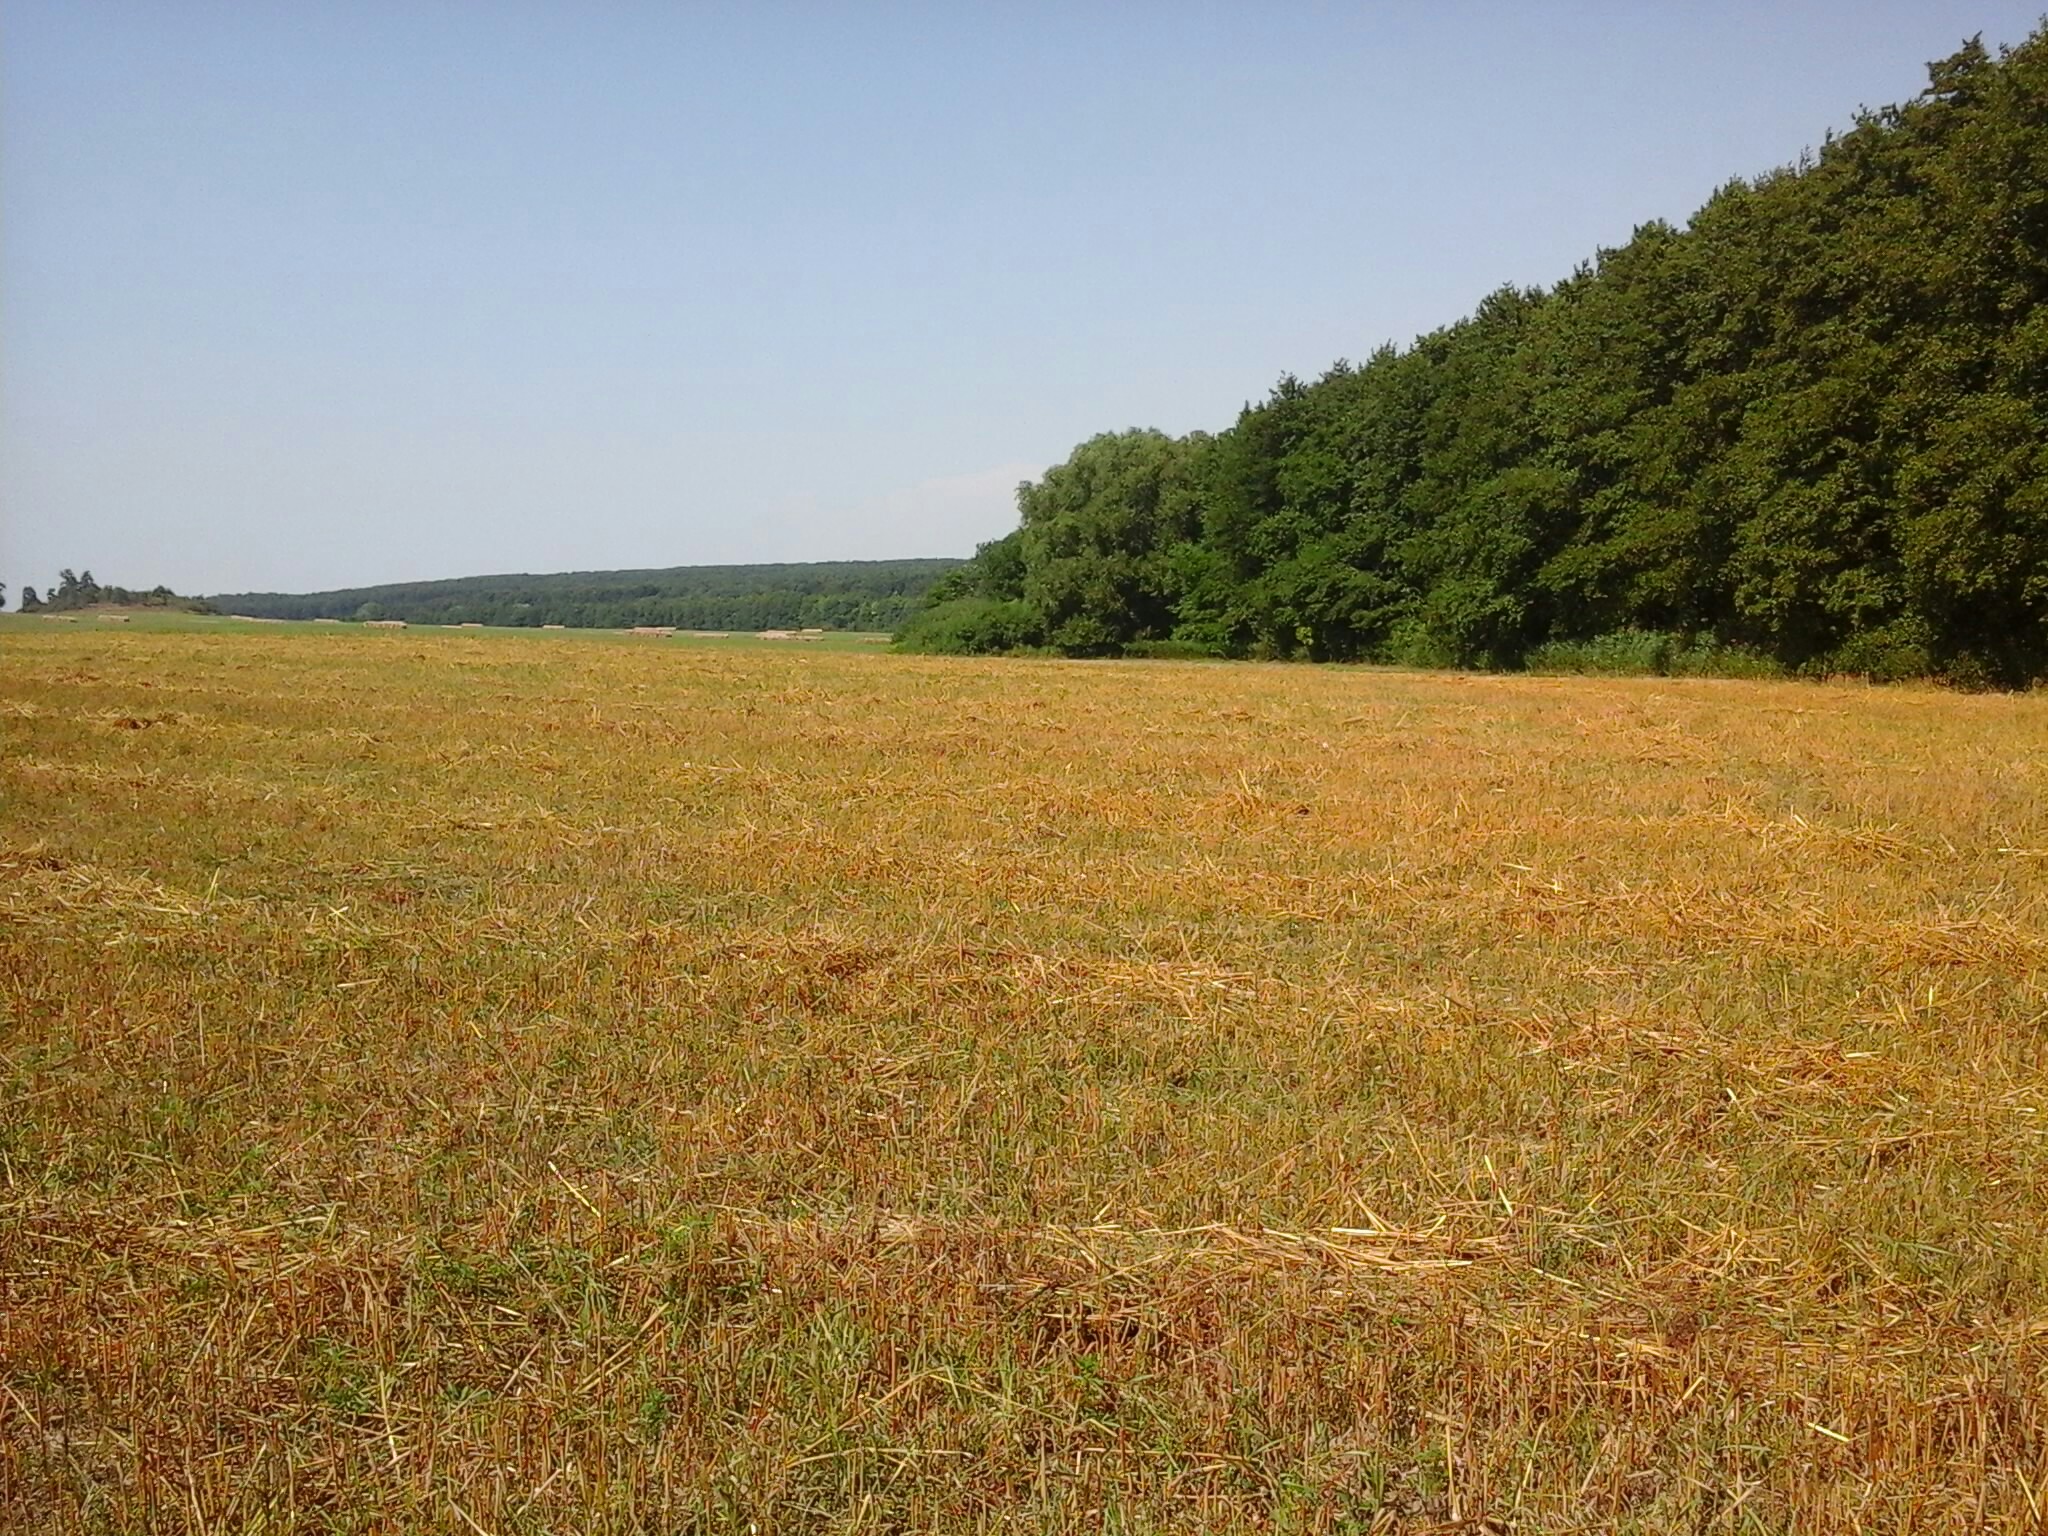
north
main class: Cropland
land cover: Common wheat
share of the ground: 50 - 75 %
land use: Agriculture (excluding fallow land and kitchen gardens)
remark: Harvested field
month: August
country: HU
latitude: 47.4220
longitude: 18.0570
